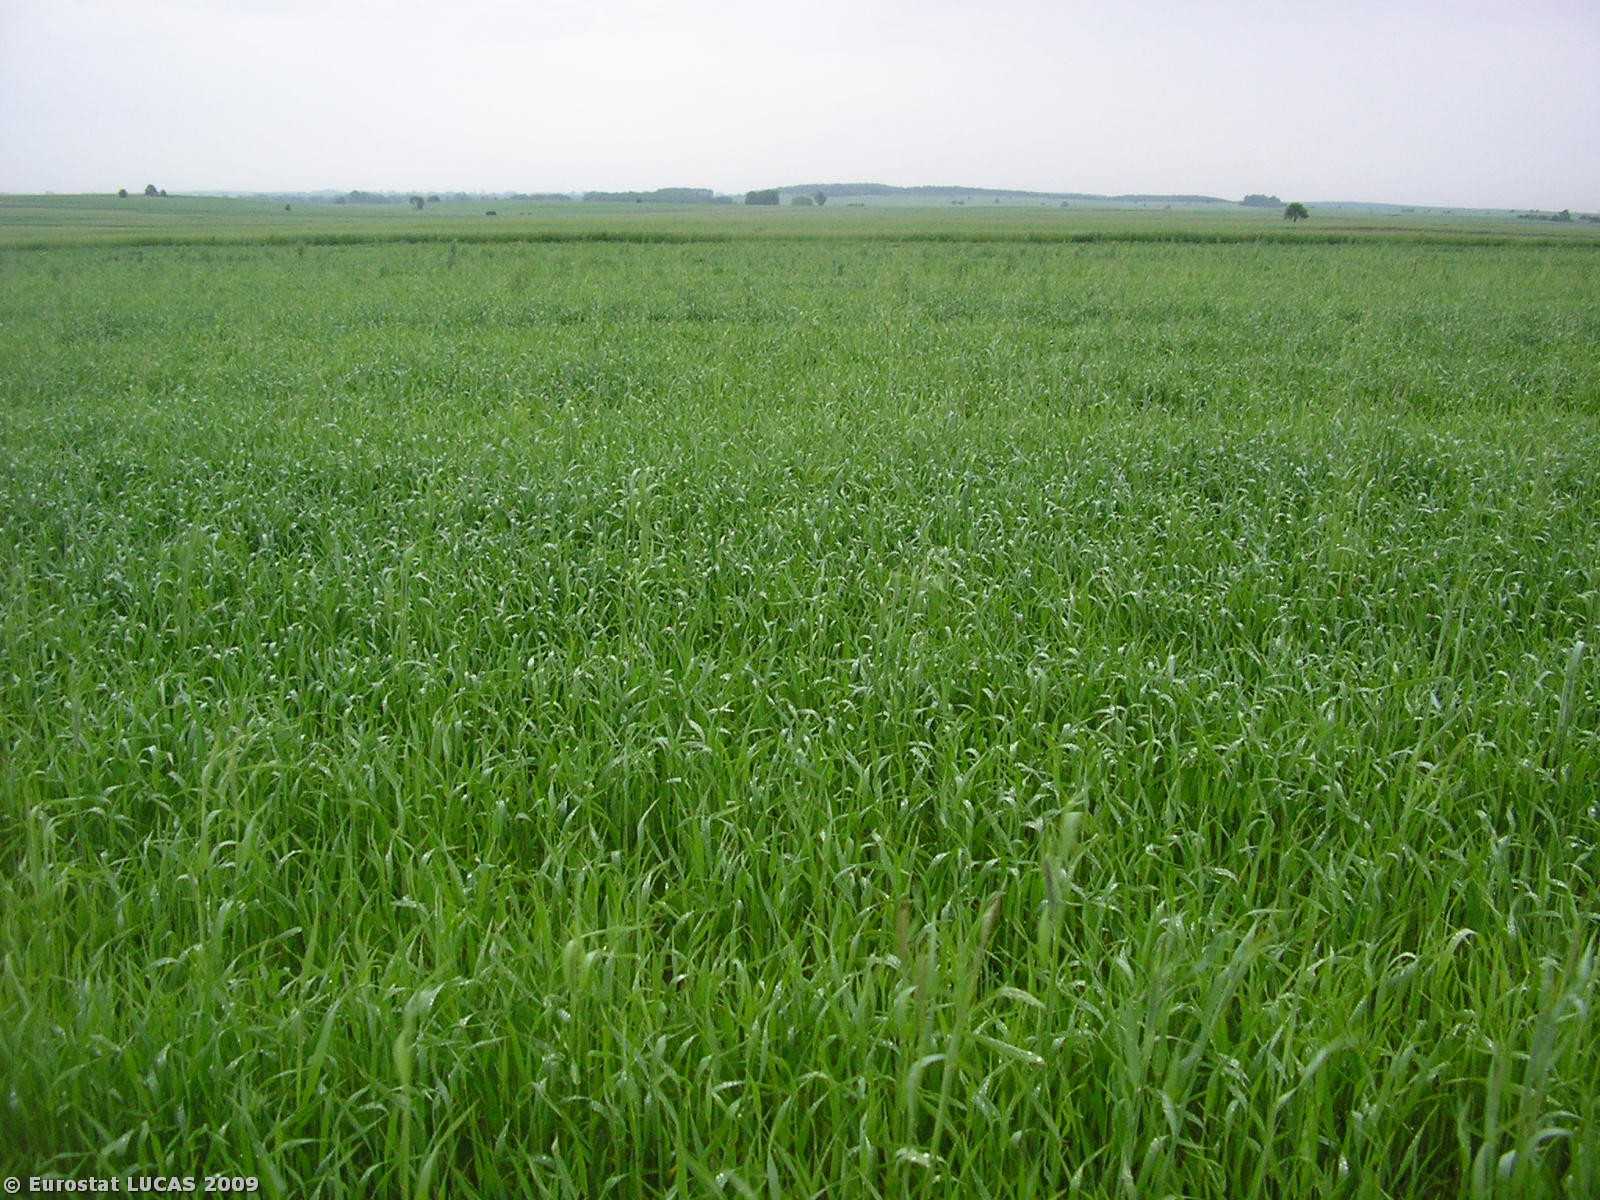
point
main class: Cropland
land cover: Triticale
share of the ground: > 75 %
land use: Agriculture (excluding fallow land and kitchen gardens)
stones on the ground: < 10 %
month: May
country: PL
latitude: 51.8248
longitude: 20.0299
